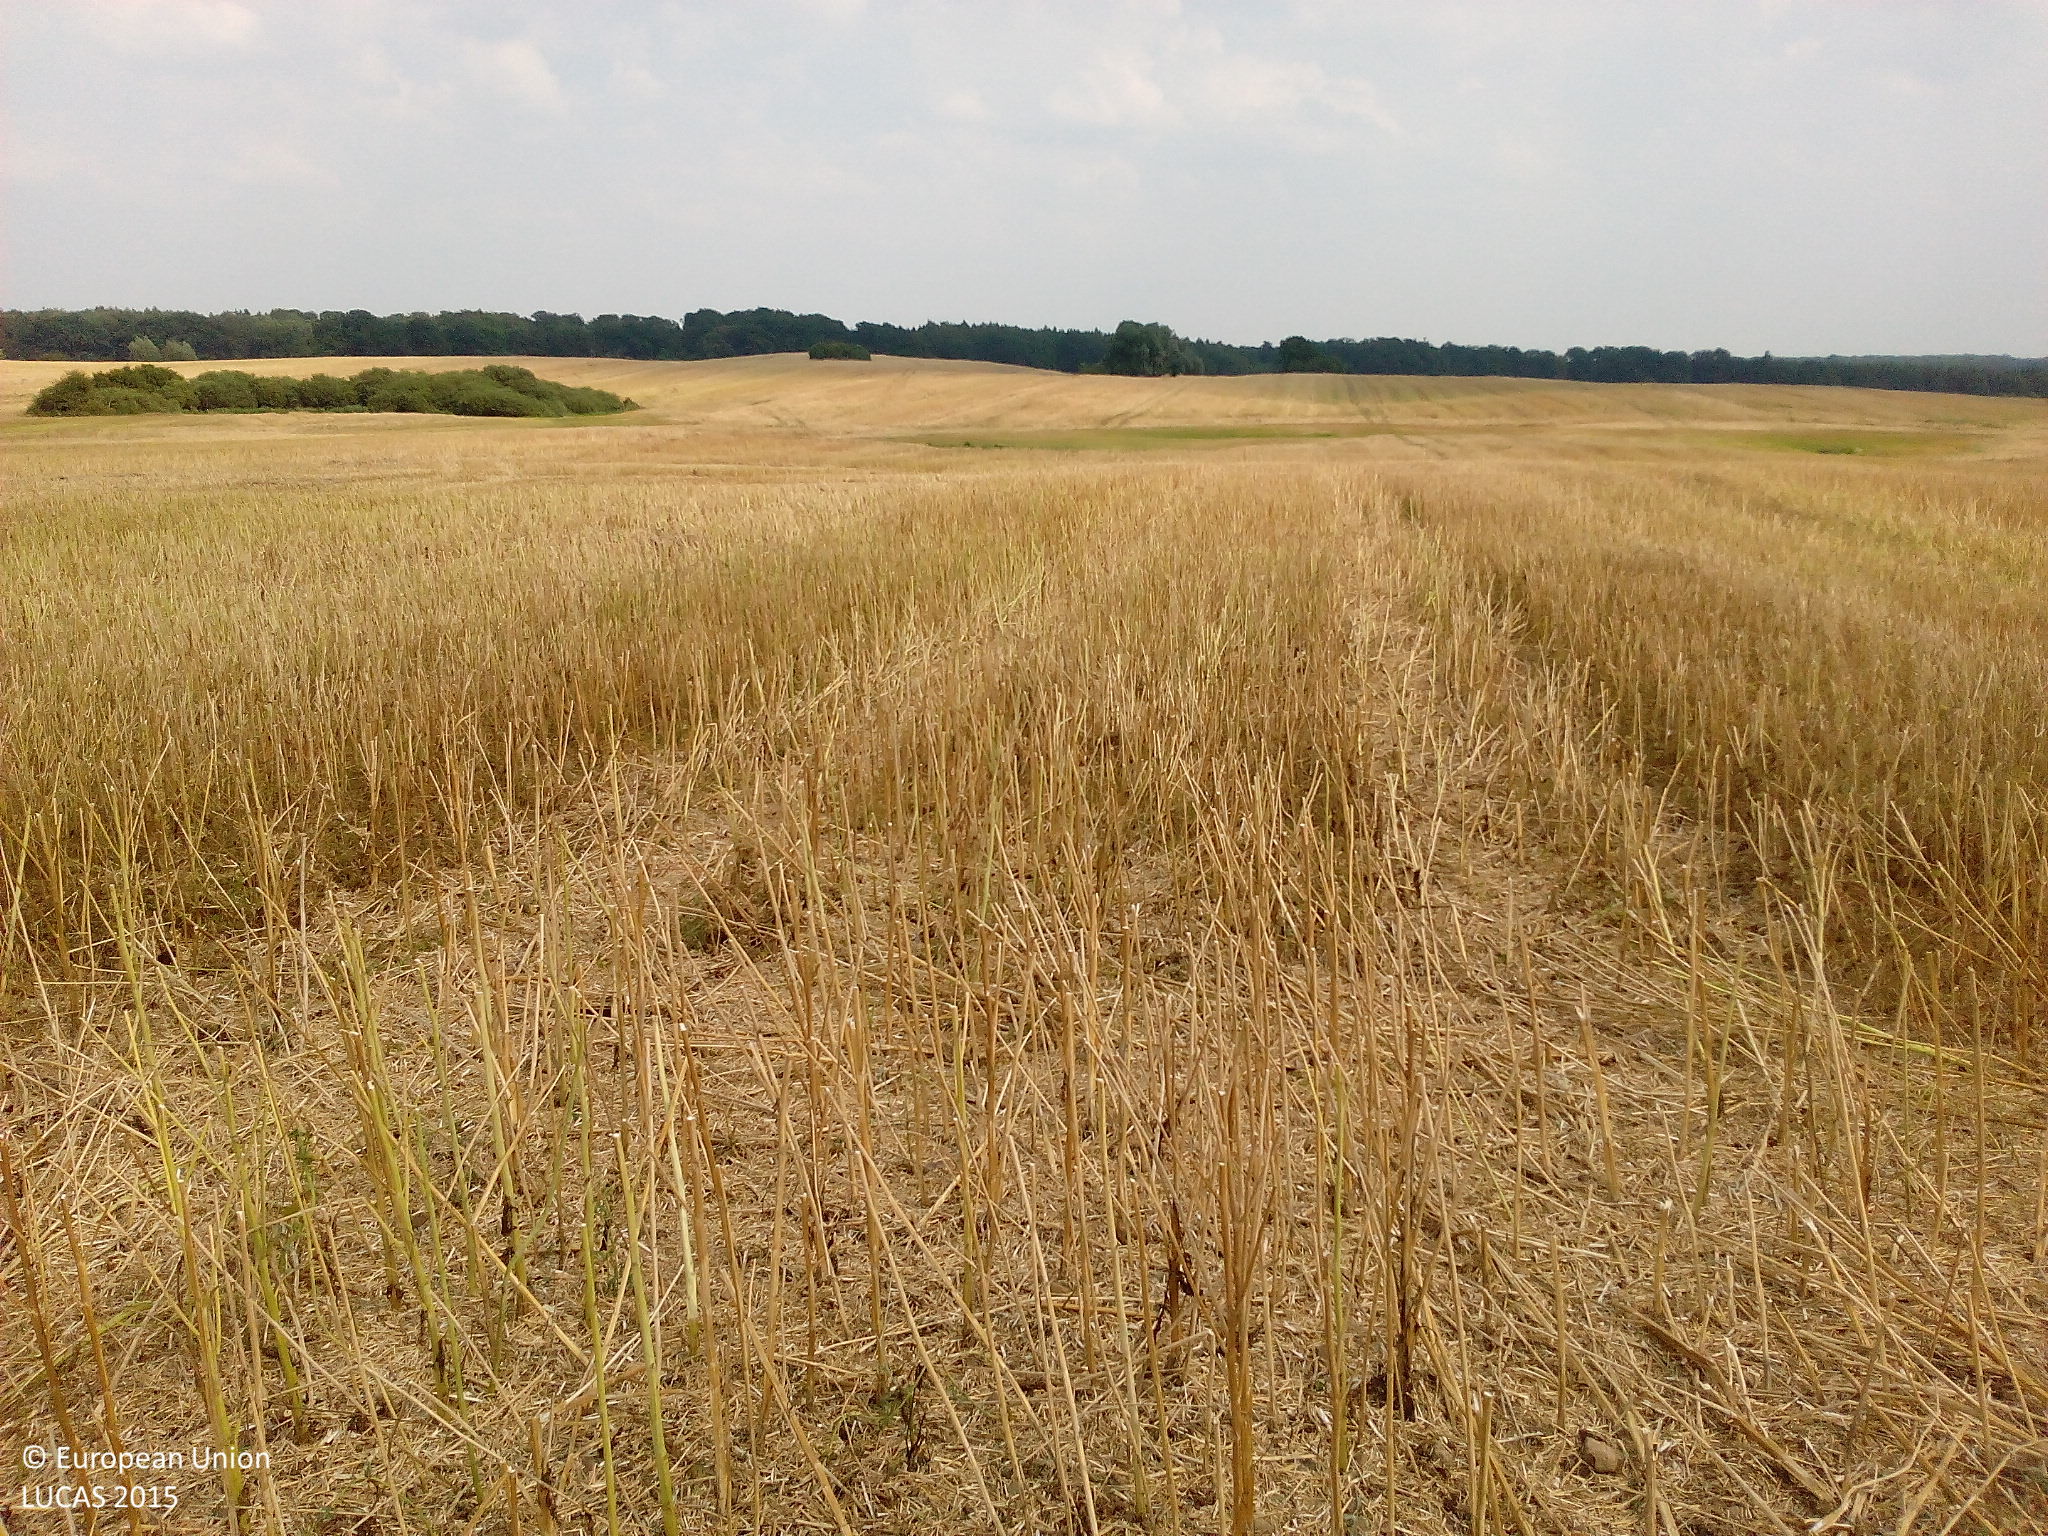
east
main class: Cropland
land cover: Rape and turnip rape
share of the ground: < 10 %
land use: Agriculture (excluding fallow land and kitchen gardens)
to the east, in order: Rape and turnip rape; Spontaneously vegetated surfaces; Shrubland without tree cover; Inland fresh water bodies; Shrubland without tree cover
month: August
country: DE
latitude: 53.5889
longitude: 12.6431
